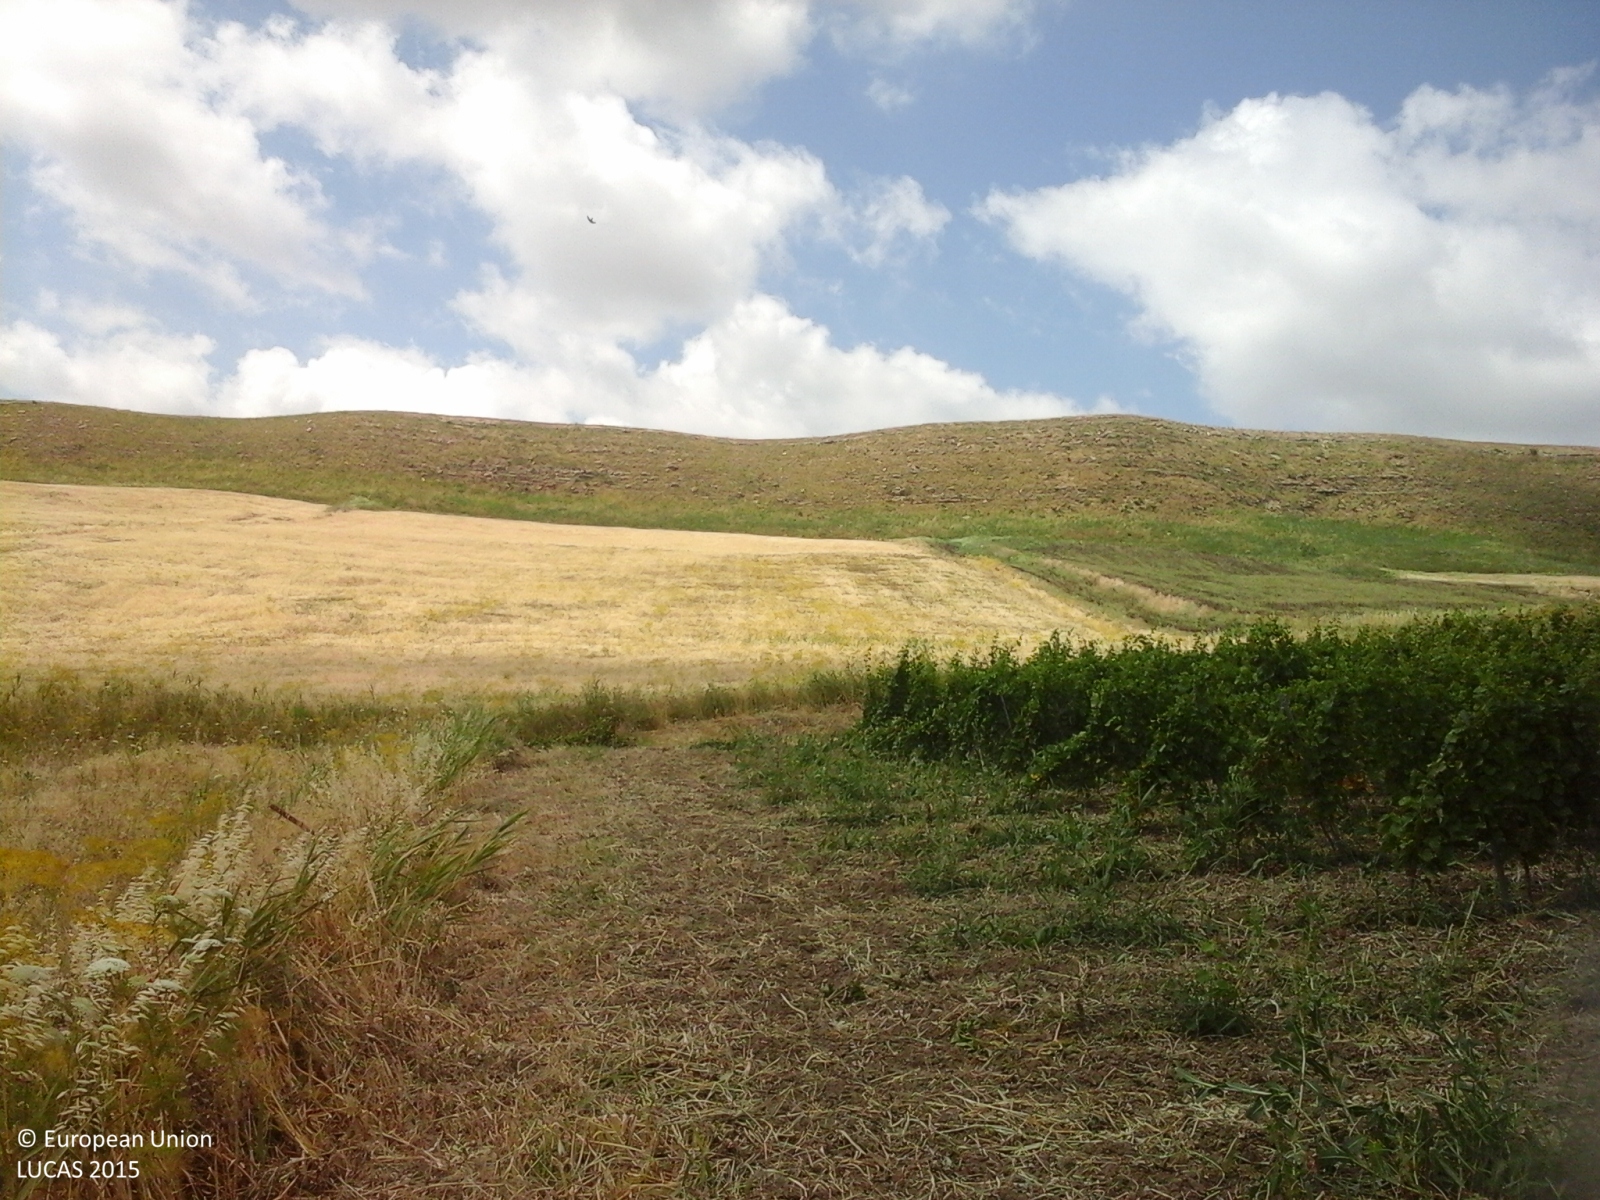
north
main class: Cropland
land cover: Durum wheat
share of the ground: > 75 %
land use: Agriculture (excluding fallow land and kitchen gardens)
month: June
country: IT
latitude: 37.6964
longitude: 13.1182
